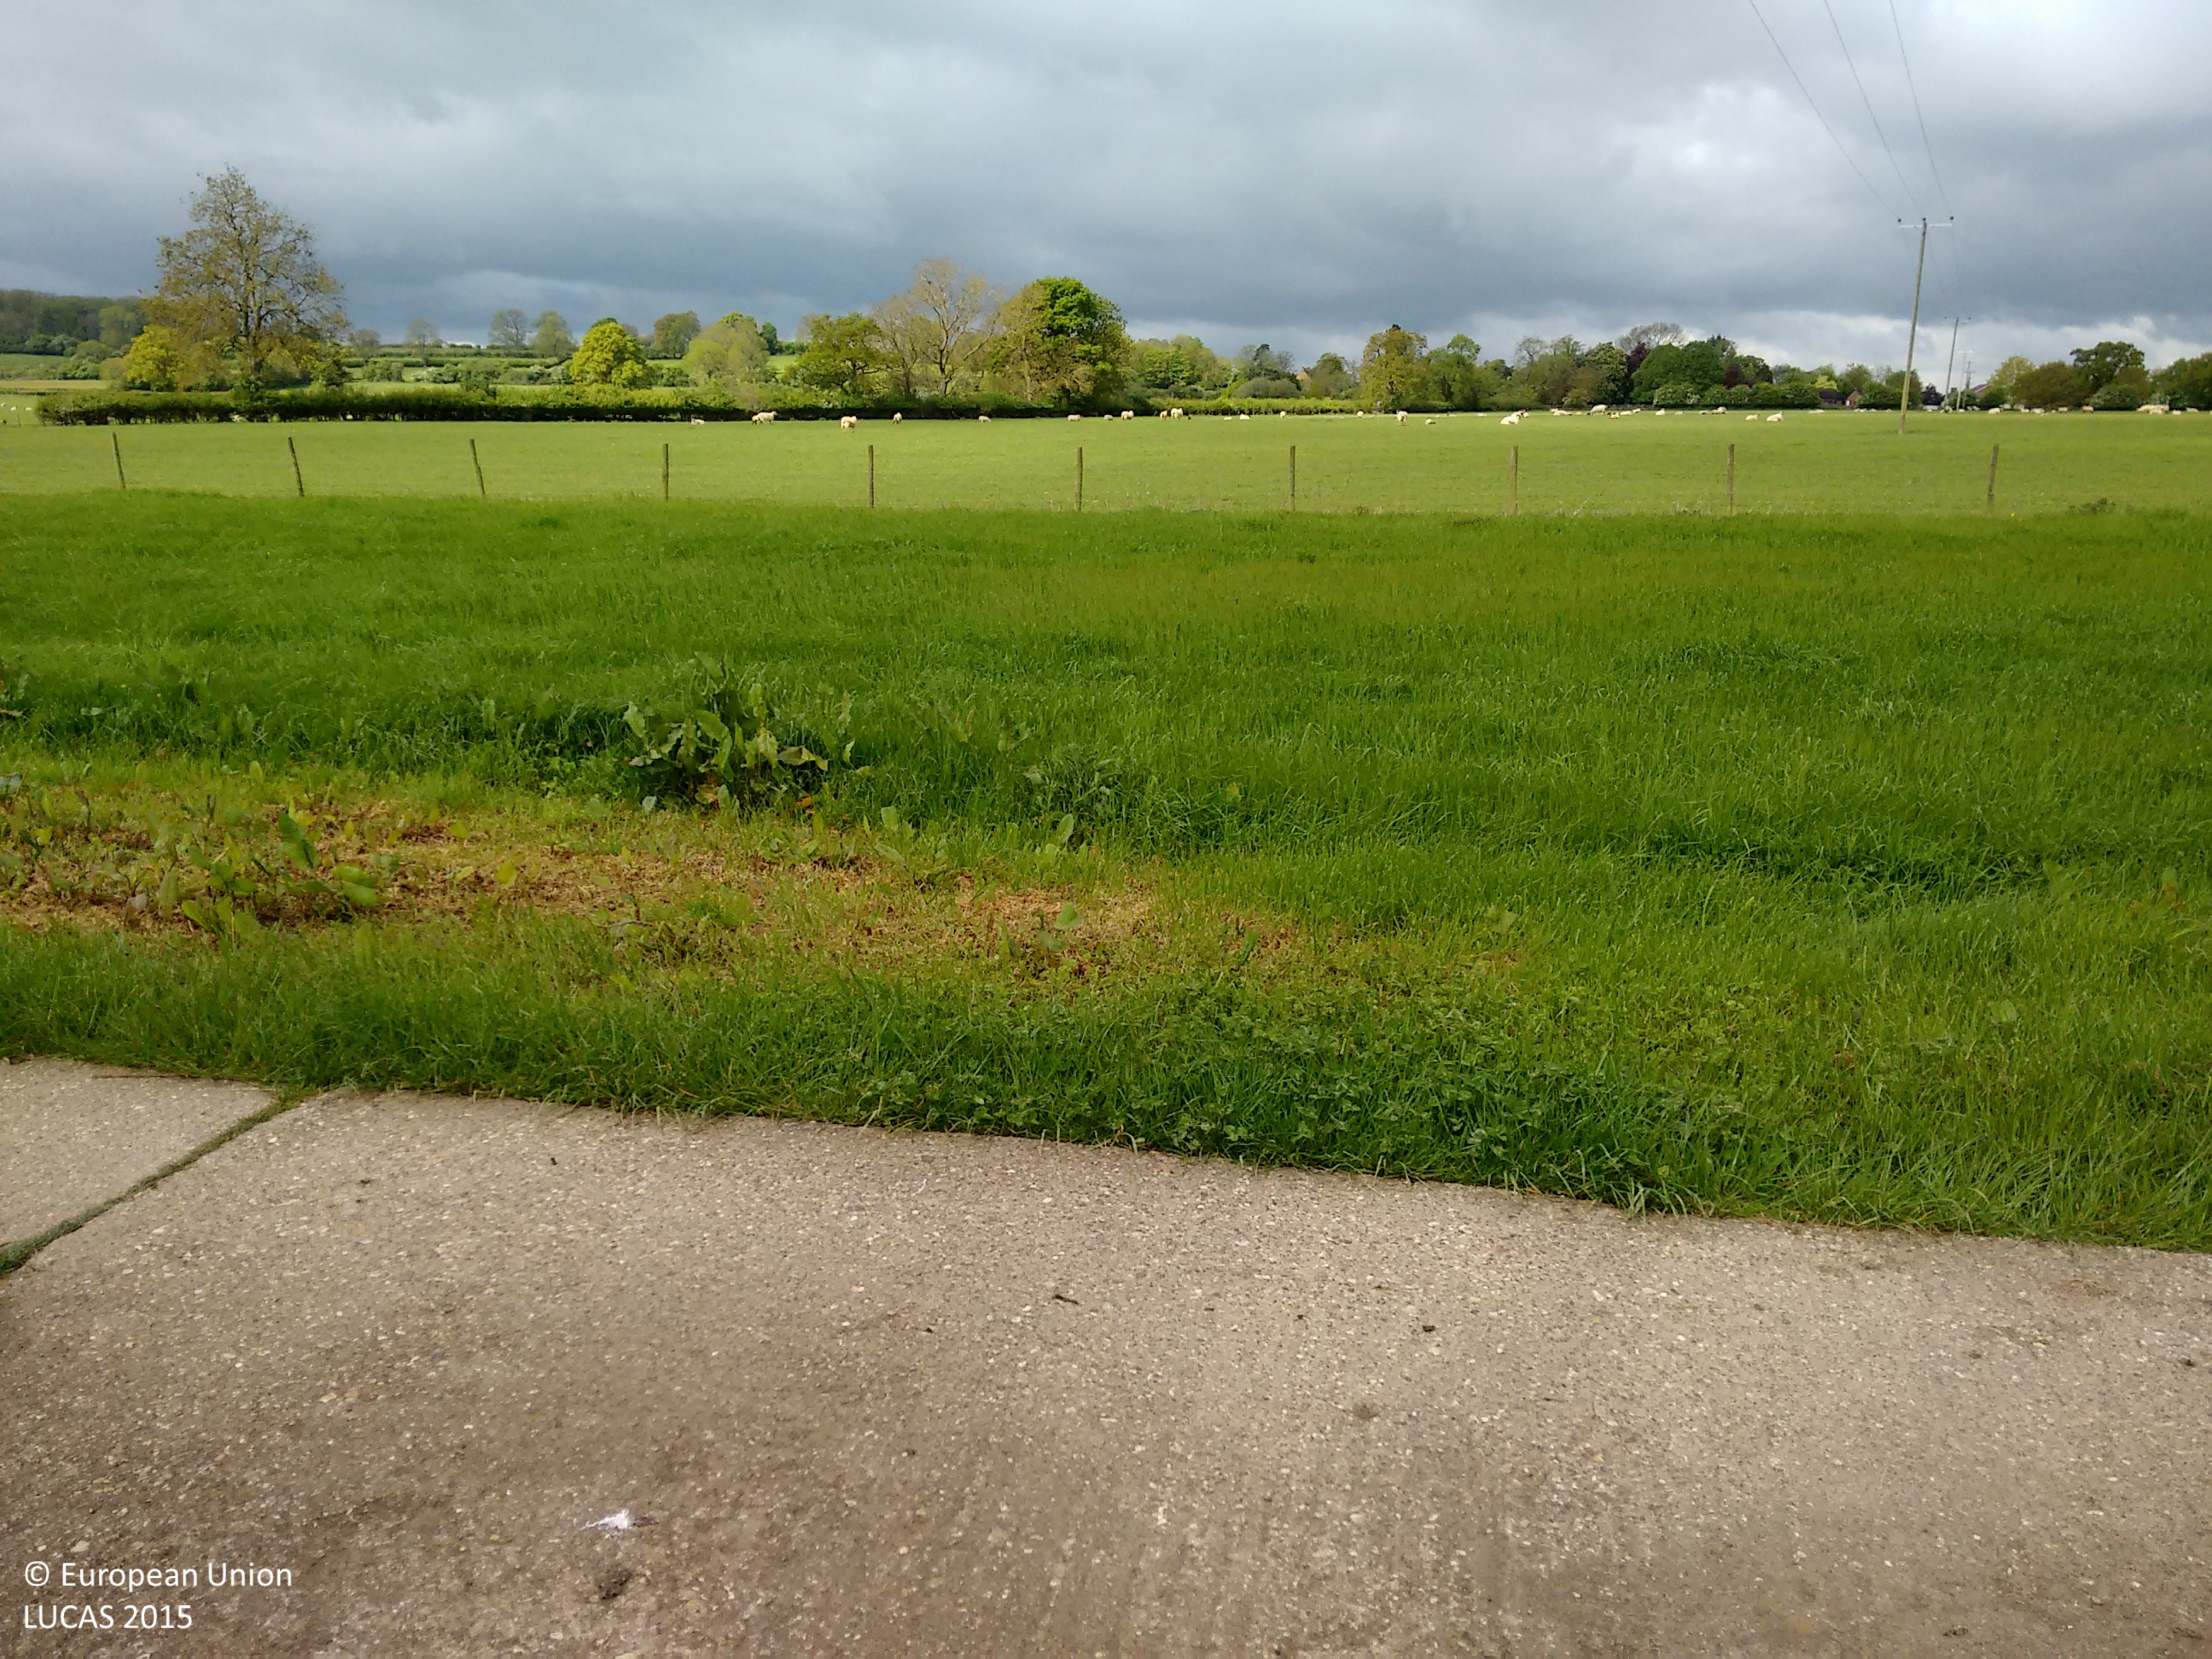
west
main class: Grassland
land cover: Grassland without tree/shrub cover
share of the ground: > 75 %
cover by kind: herbaceous plants 100 %
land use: Agriculture (excluding fallow land and kitchen gardens)
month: May
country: GB
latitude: 52.1992
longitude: -1.2995
